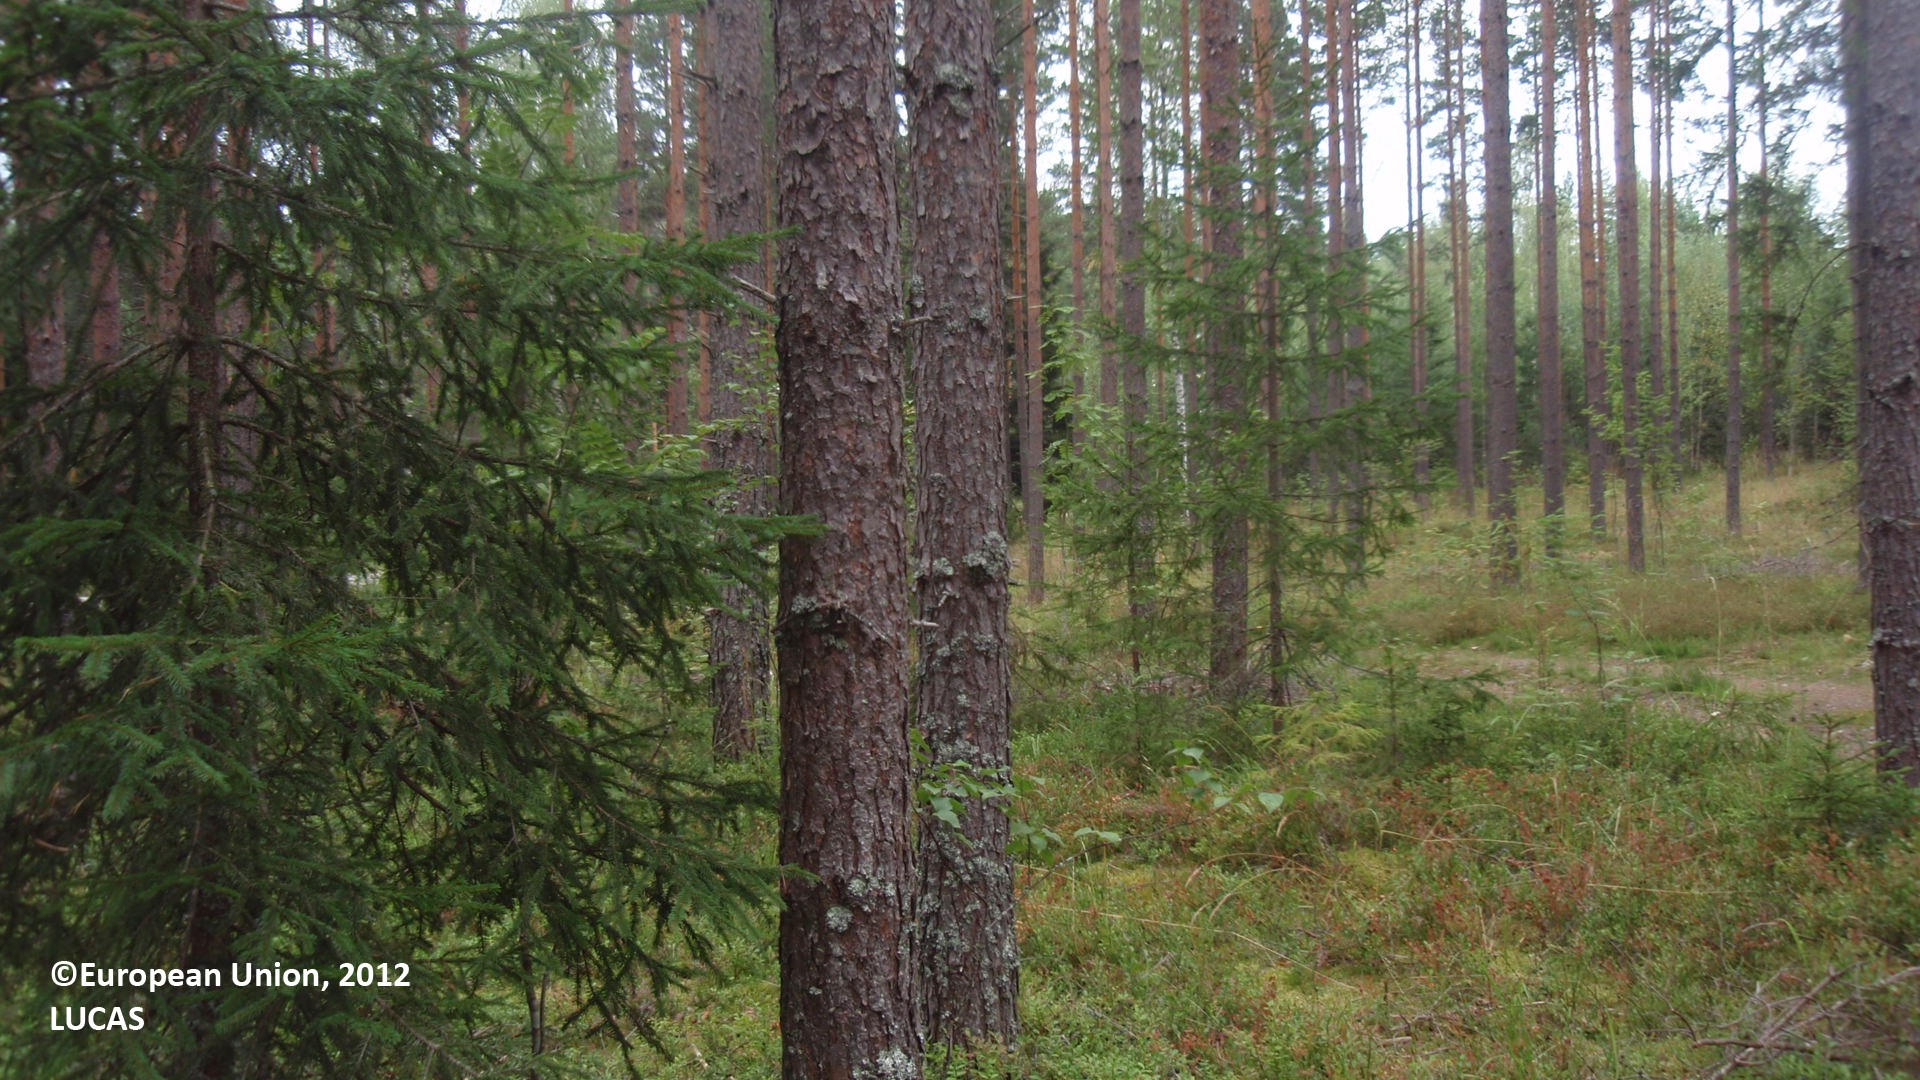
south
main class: Woodland
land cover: Pine dominated coniferous woodland
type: boreal forest
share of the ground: 50 - 75 %
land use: Forestry
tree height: > 5 m
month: August
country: FI
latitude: 60.7769
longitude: 27.3480
